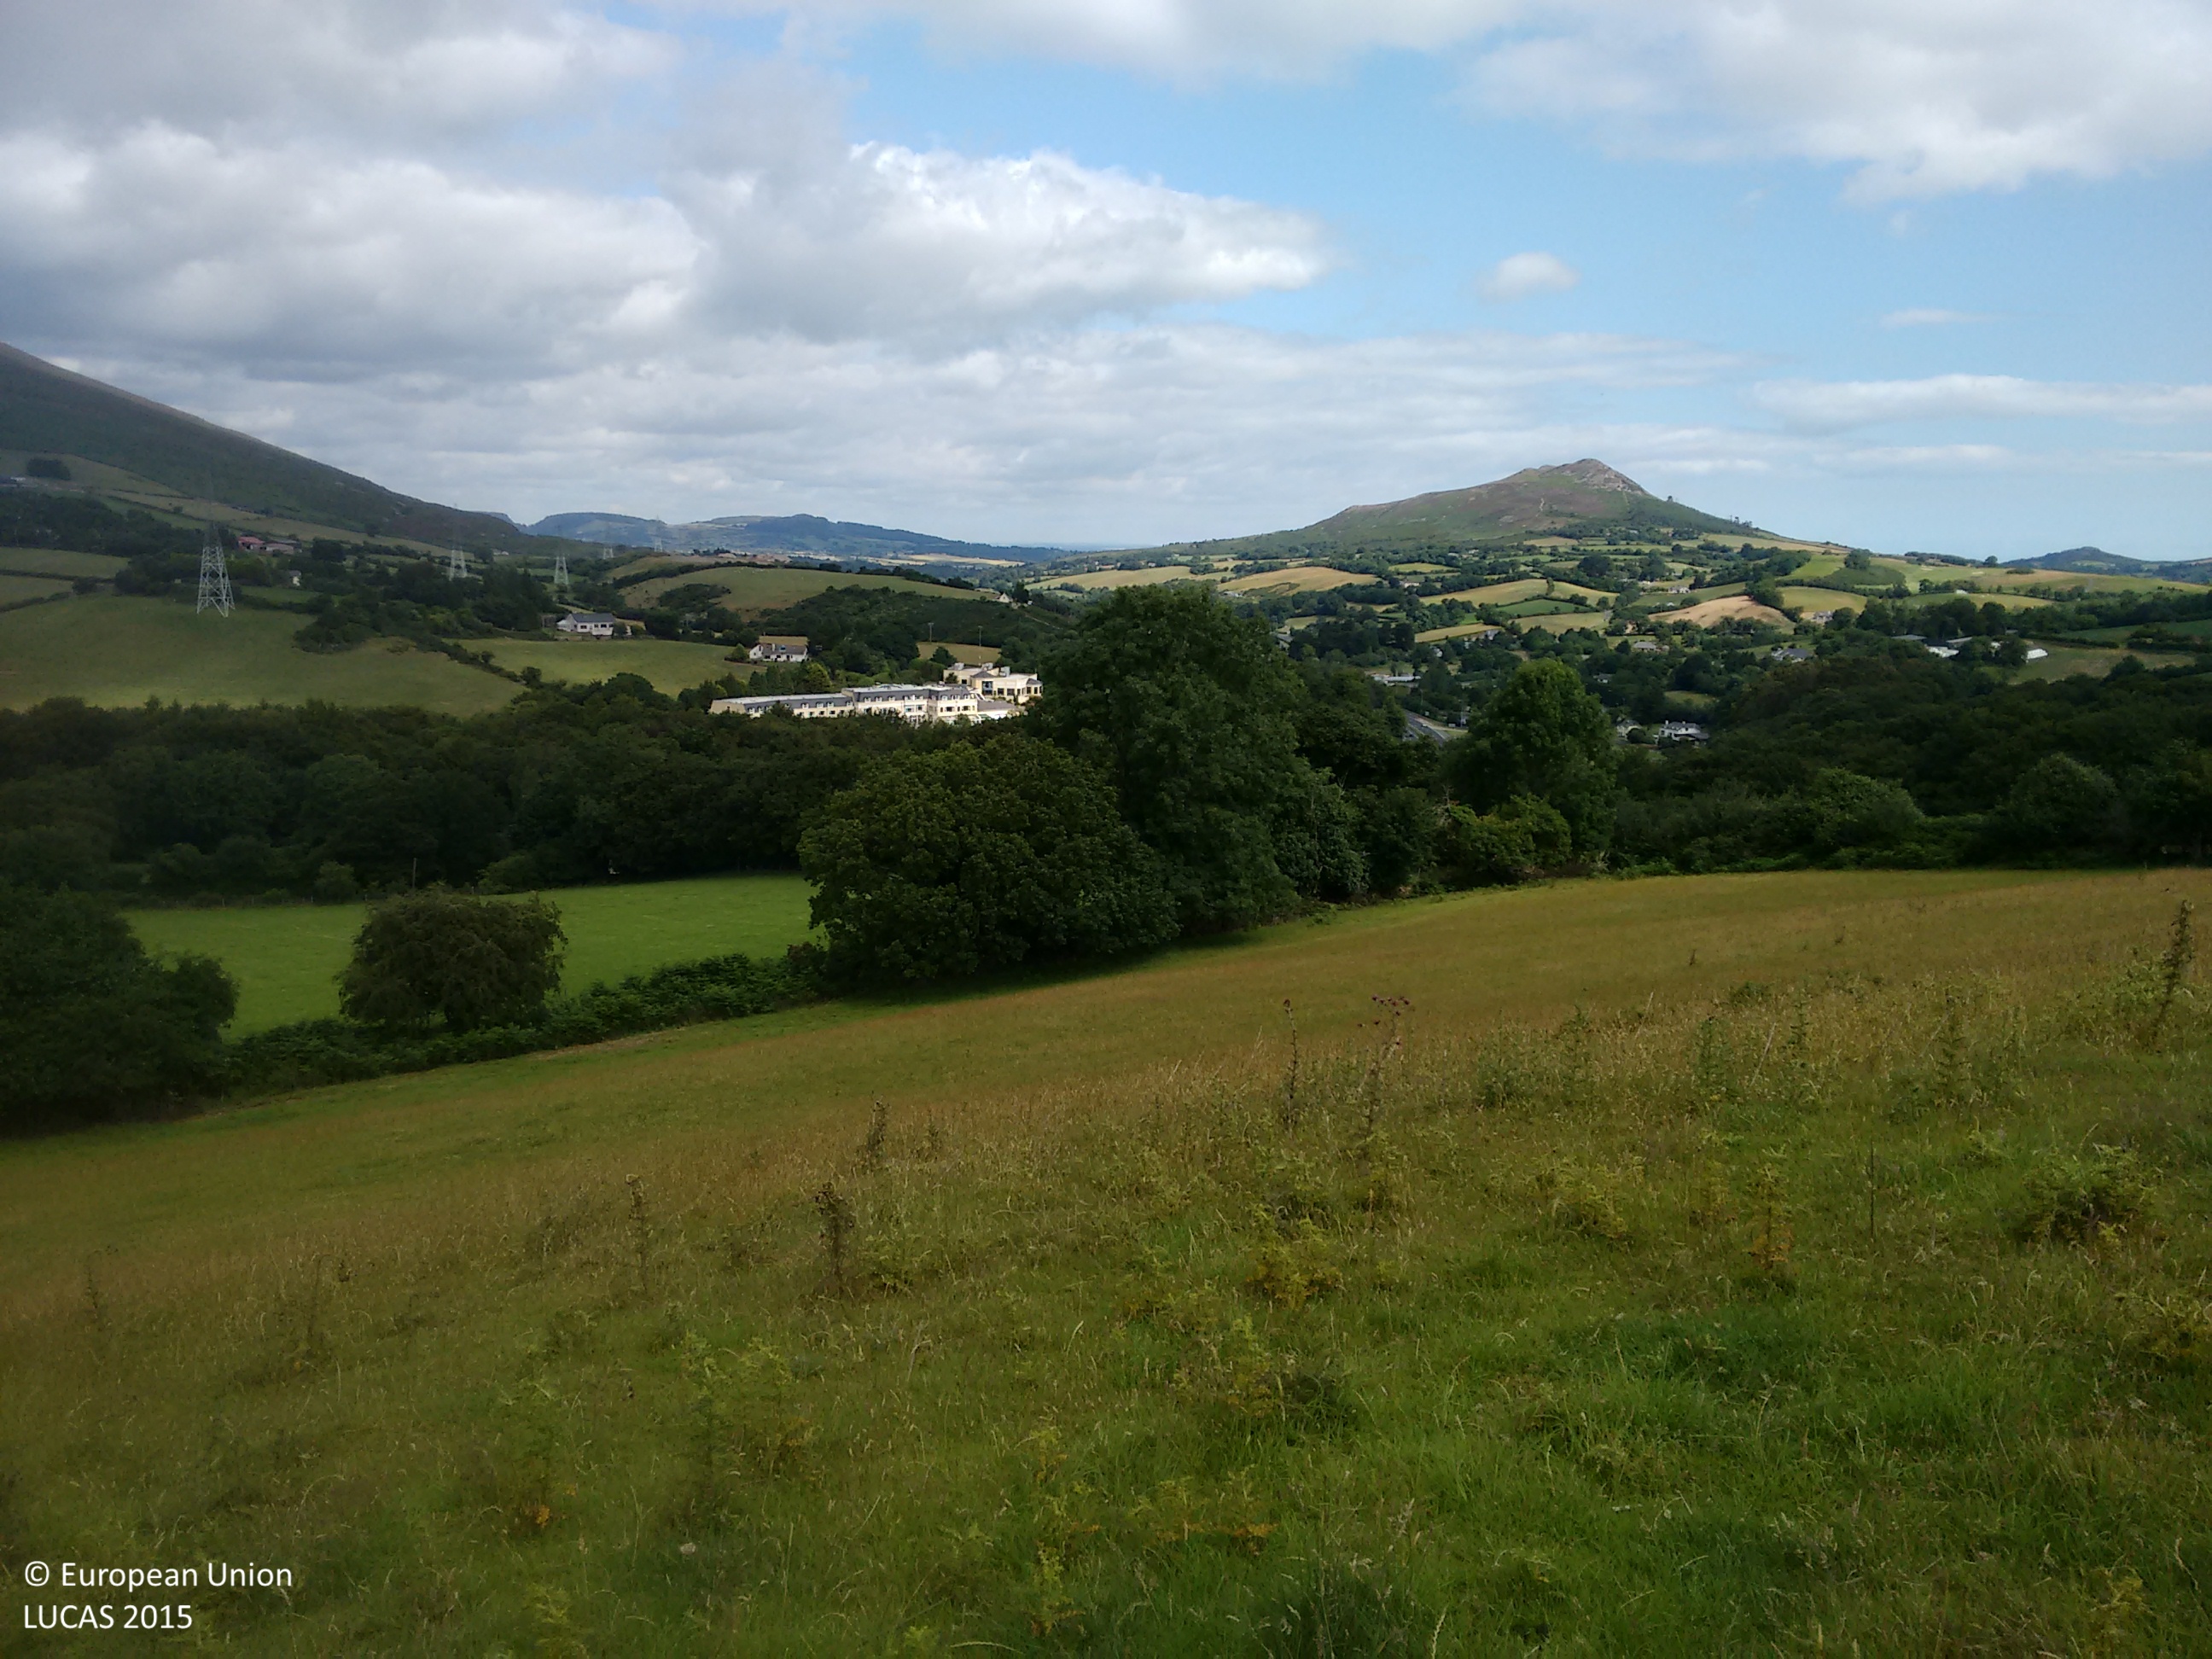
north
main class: Grassland
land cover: Grassland without tree/shrub cover
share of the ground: > 75 %
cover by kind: herbaceous plants 100 %
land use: Agriculture (excluding fallow land and kitchen gardens)
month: July
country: IE
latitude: 53.1369
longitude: -6.1256
